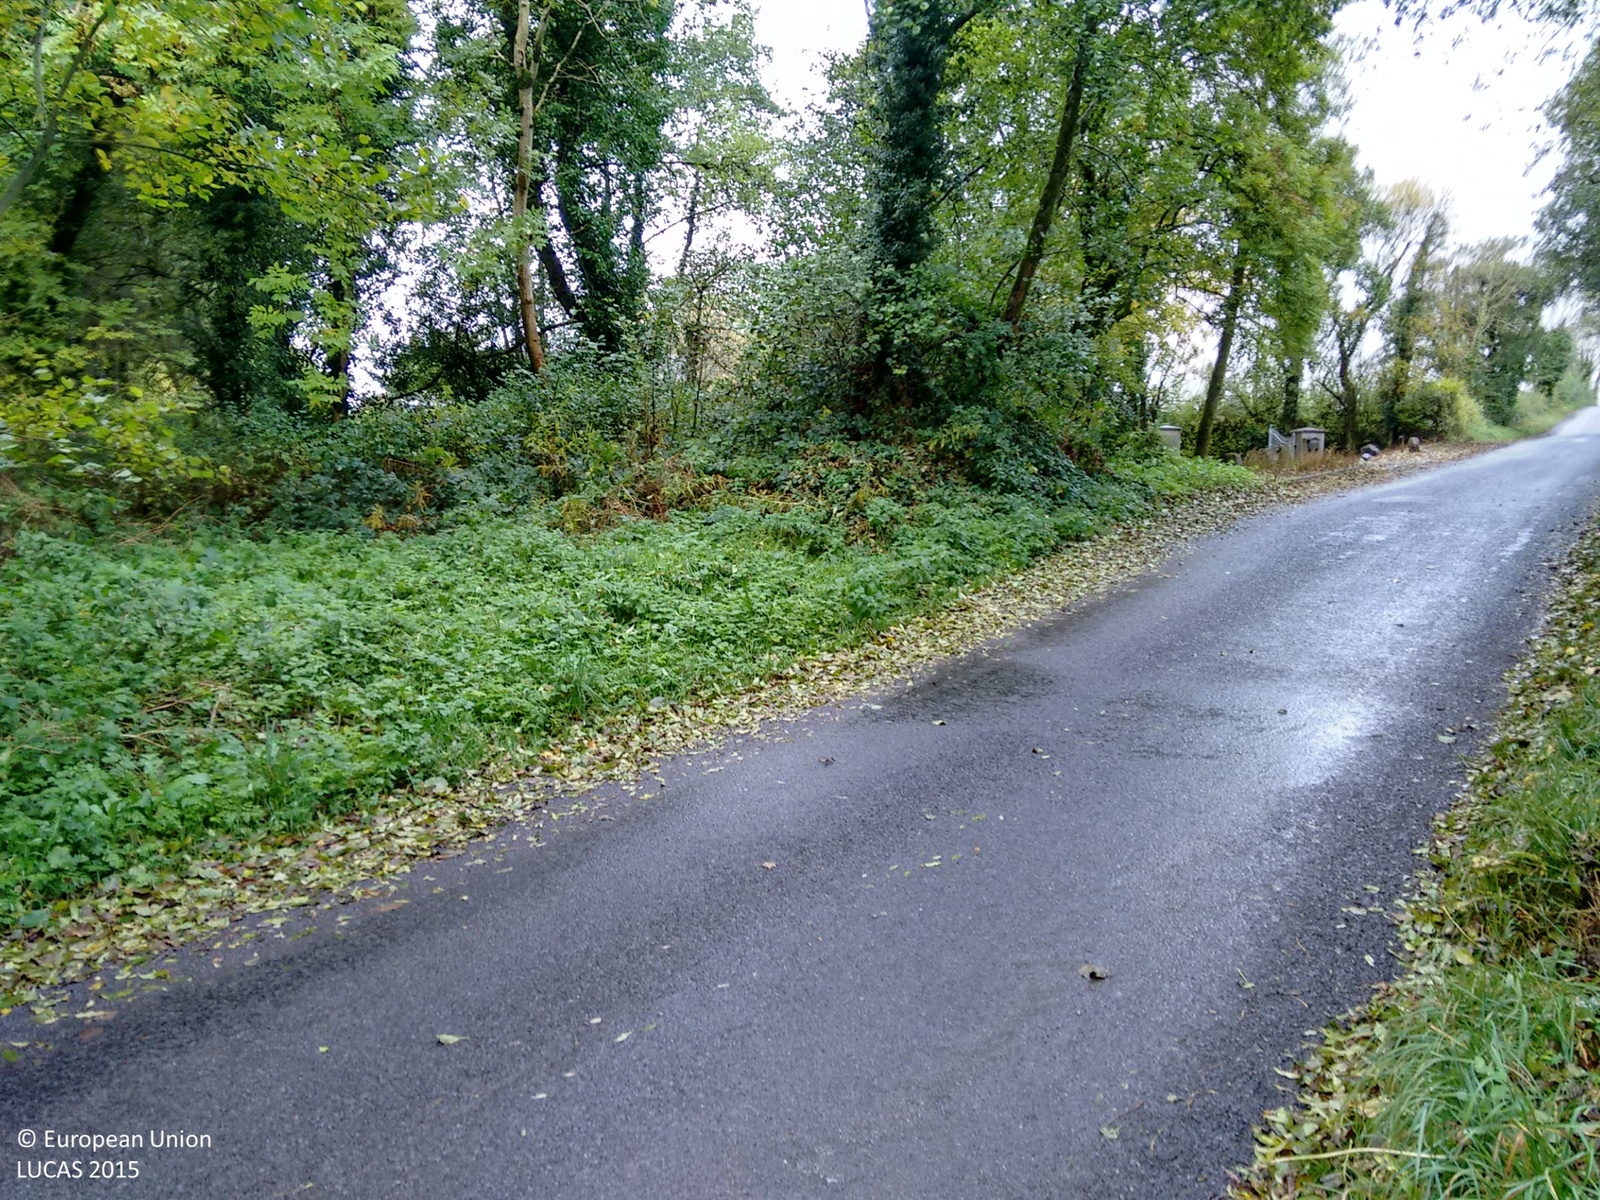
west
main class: Grassland
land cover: Grassland with sparse tree/shrub cover
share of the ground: > 75 %
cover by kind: herbaceous plants 95 %, broadleaved forest trees 5 %
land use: Agriculture (excluding fallow land and kitchen gardens)
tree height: < 5 m
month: October
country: GB
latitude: 54.5134
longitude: -7.4702
